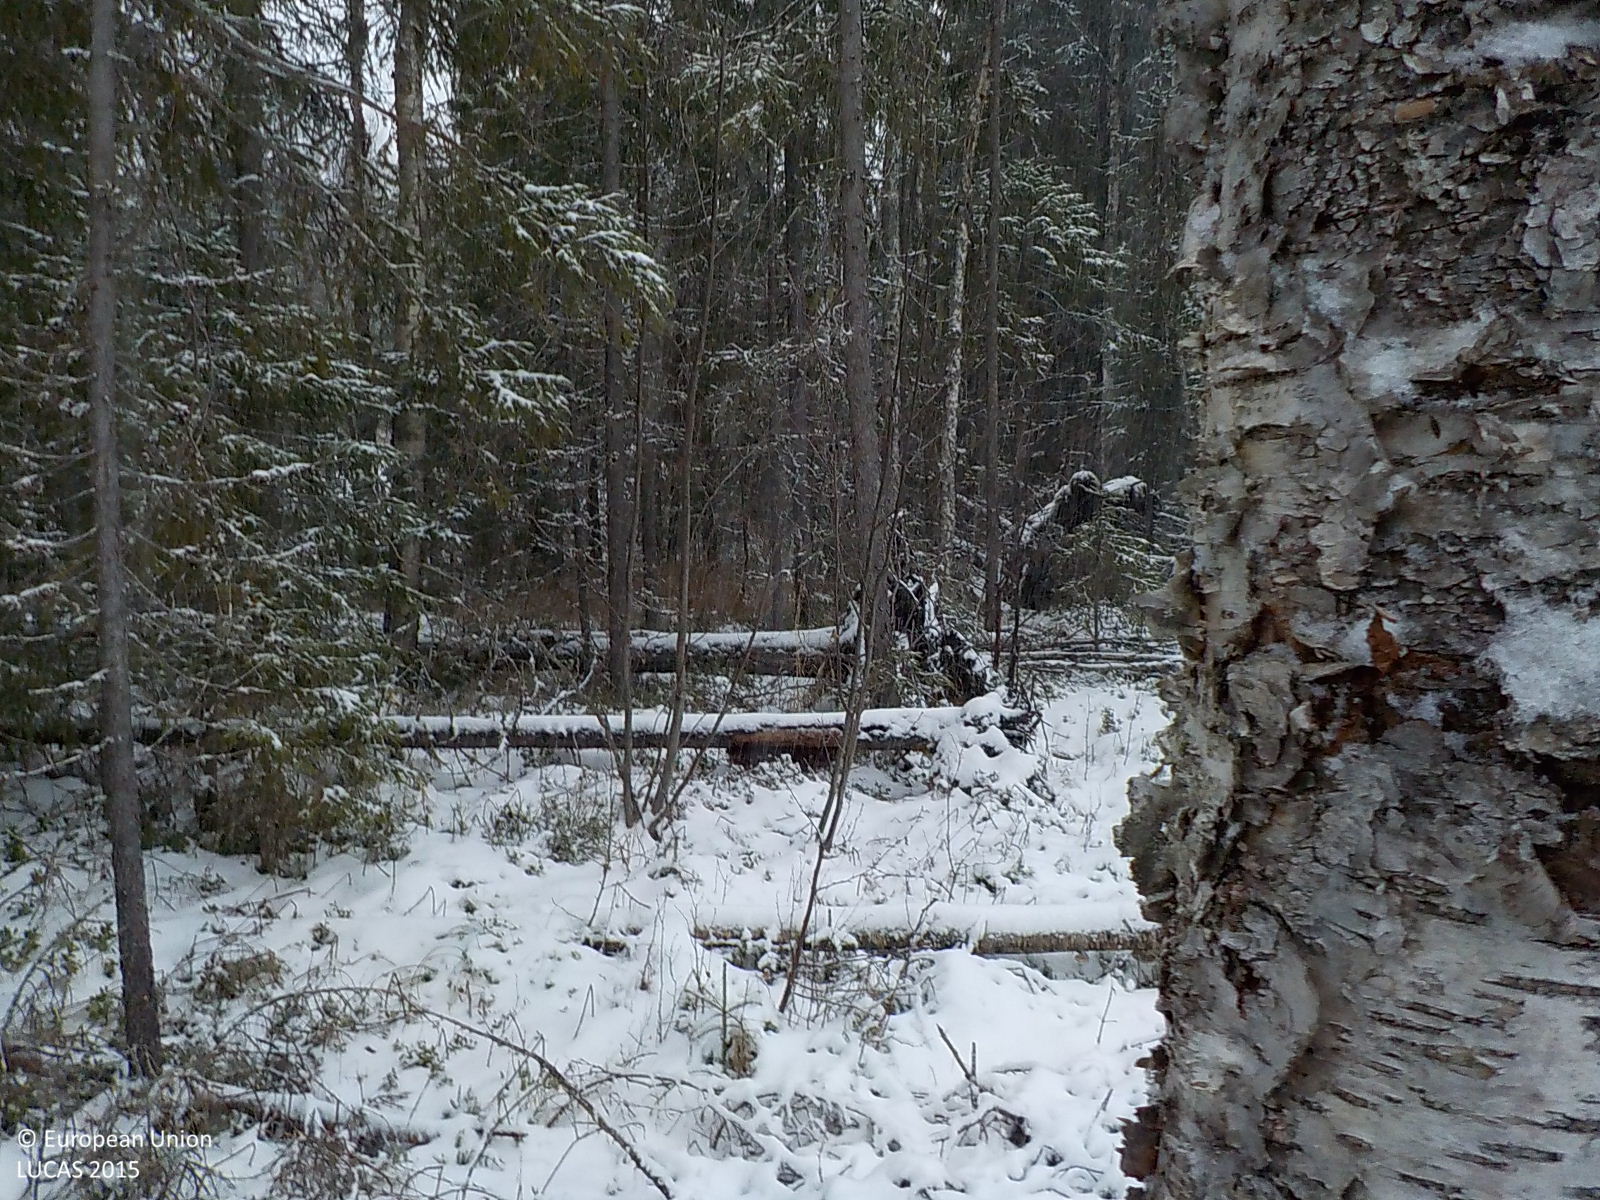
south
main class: Woodland
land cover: Other mixed woodland
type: boreal forest
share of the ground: 50 - 75 %
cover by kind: broadleaved forest trees 40 %, coniferous forest trees 30 %, herbaceous plants 30 %
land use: Forestry
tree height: > 5 m
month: December
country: SE
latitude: 63.3020
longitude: 16.9773
